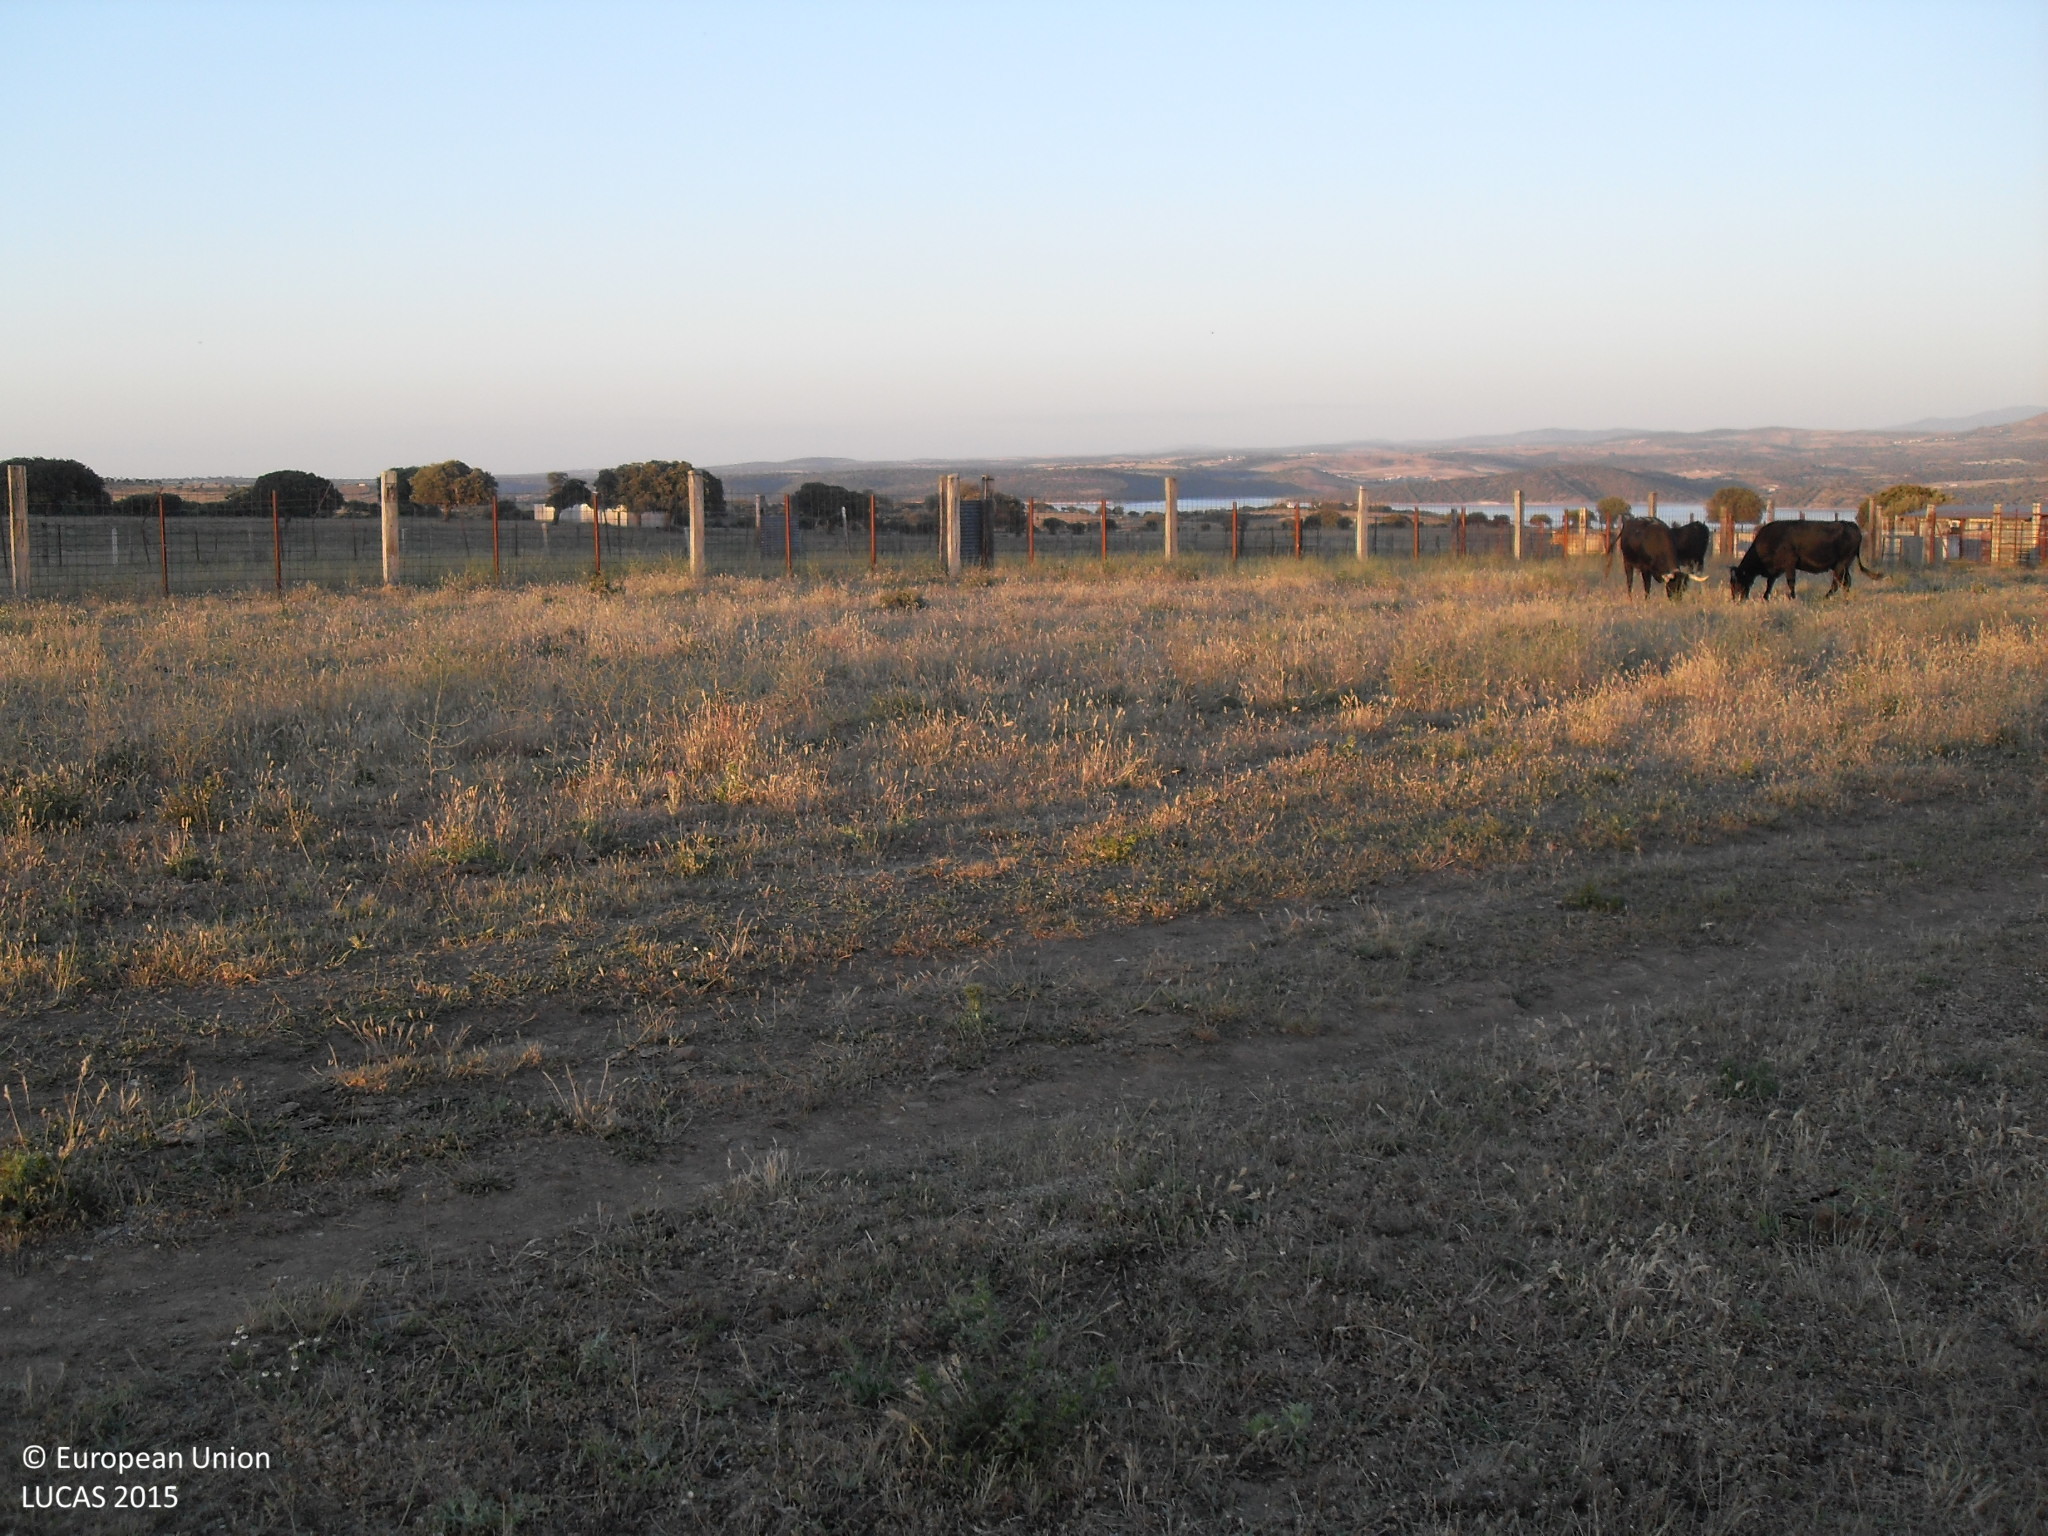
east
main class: Grassland
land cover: Grassland without tree/shrub cover
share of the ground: > 75 %
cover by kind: herbaceous plants 100 %
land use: Agriculture (excluding fallow land and kitchen gardens)
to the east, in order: Grassland without tree/shrub cover; Tracks; Grassland without tree/shrub cover; Fences; Grassland without tree/shrub cover; Fences; Grass margins; Tracks; Grass margins; Fences; Grassland without tree/shrub cover
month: June
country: ES
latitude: 40.5867
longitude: -5.6314
